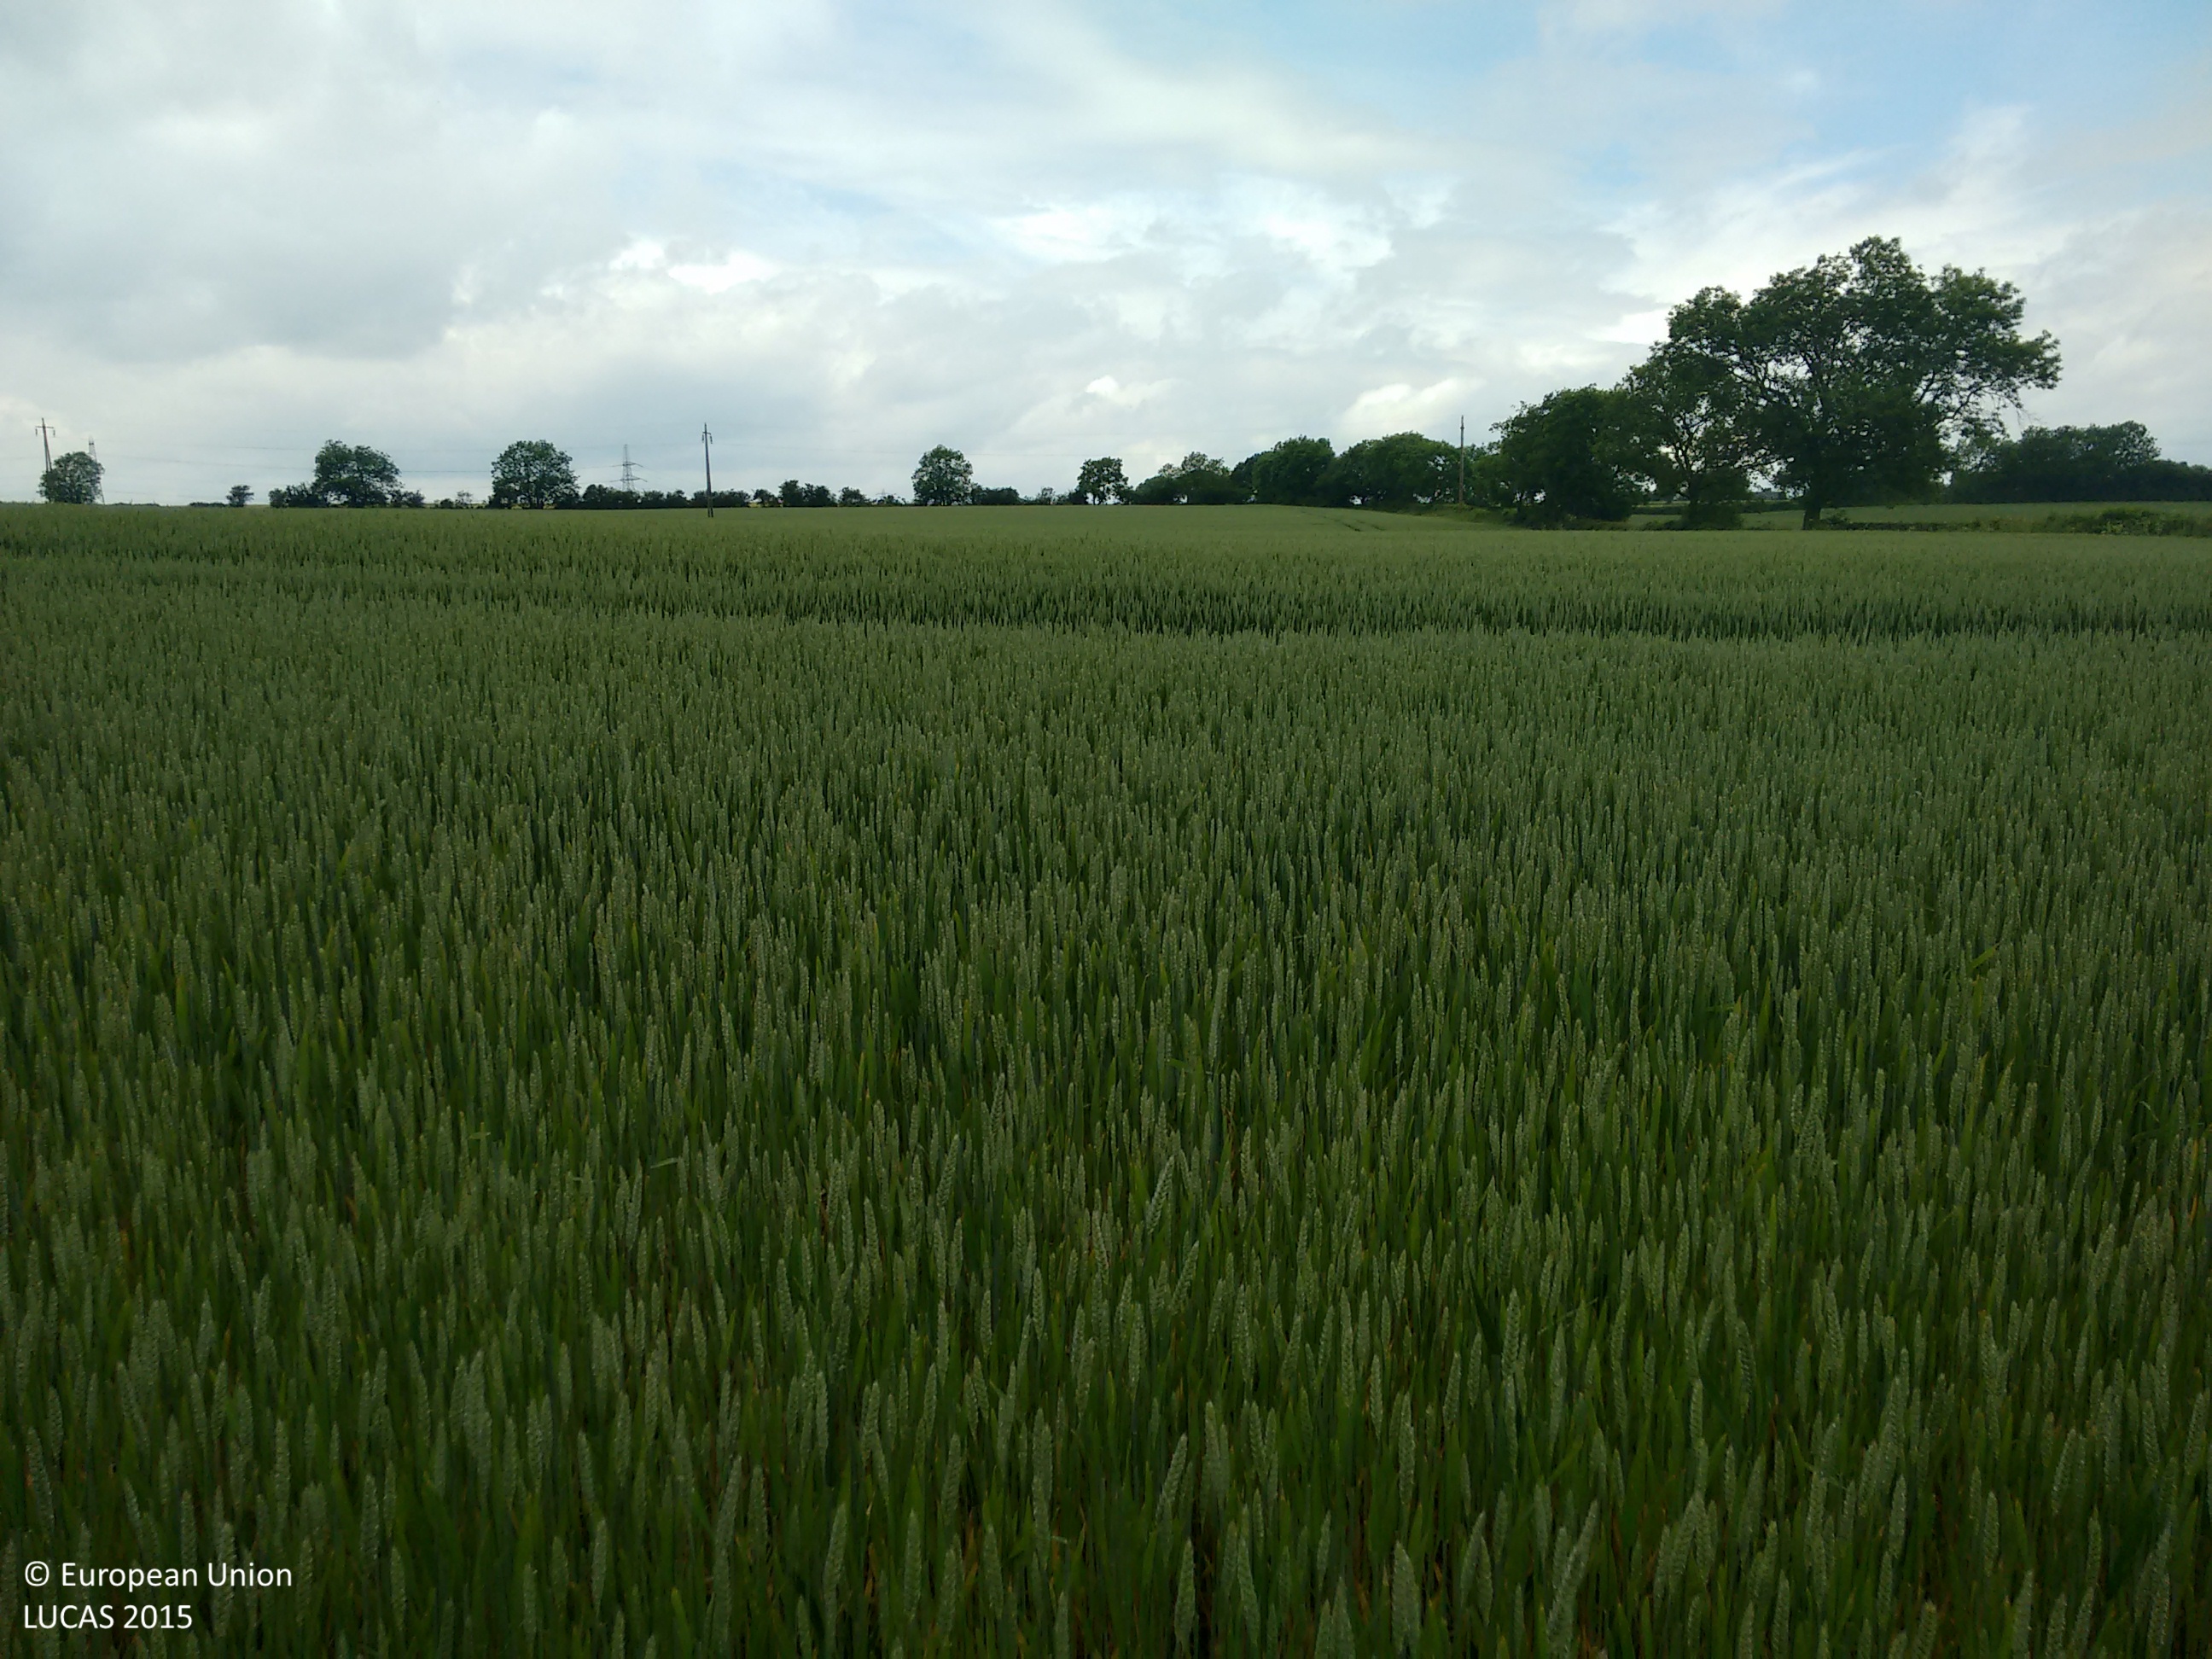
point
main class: Cropland
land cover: Common wheat
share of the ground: > 75 %
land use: Agriculture (excluding fallow land and kitchen gardens)
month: June
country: GB
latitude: 54.7187
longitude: -1.5523
